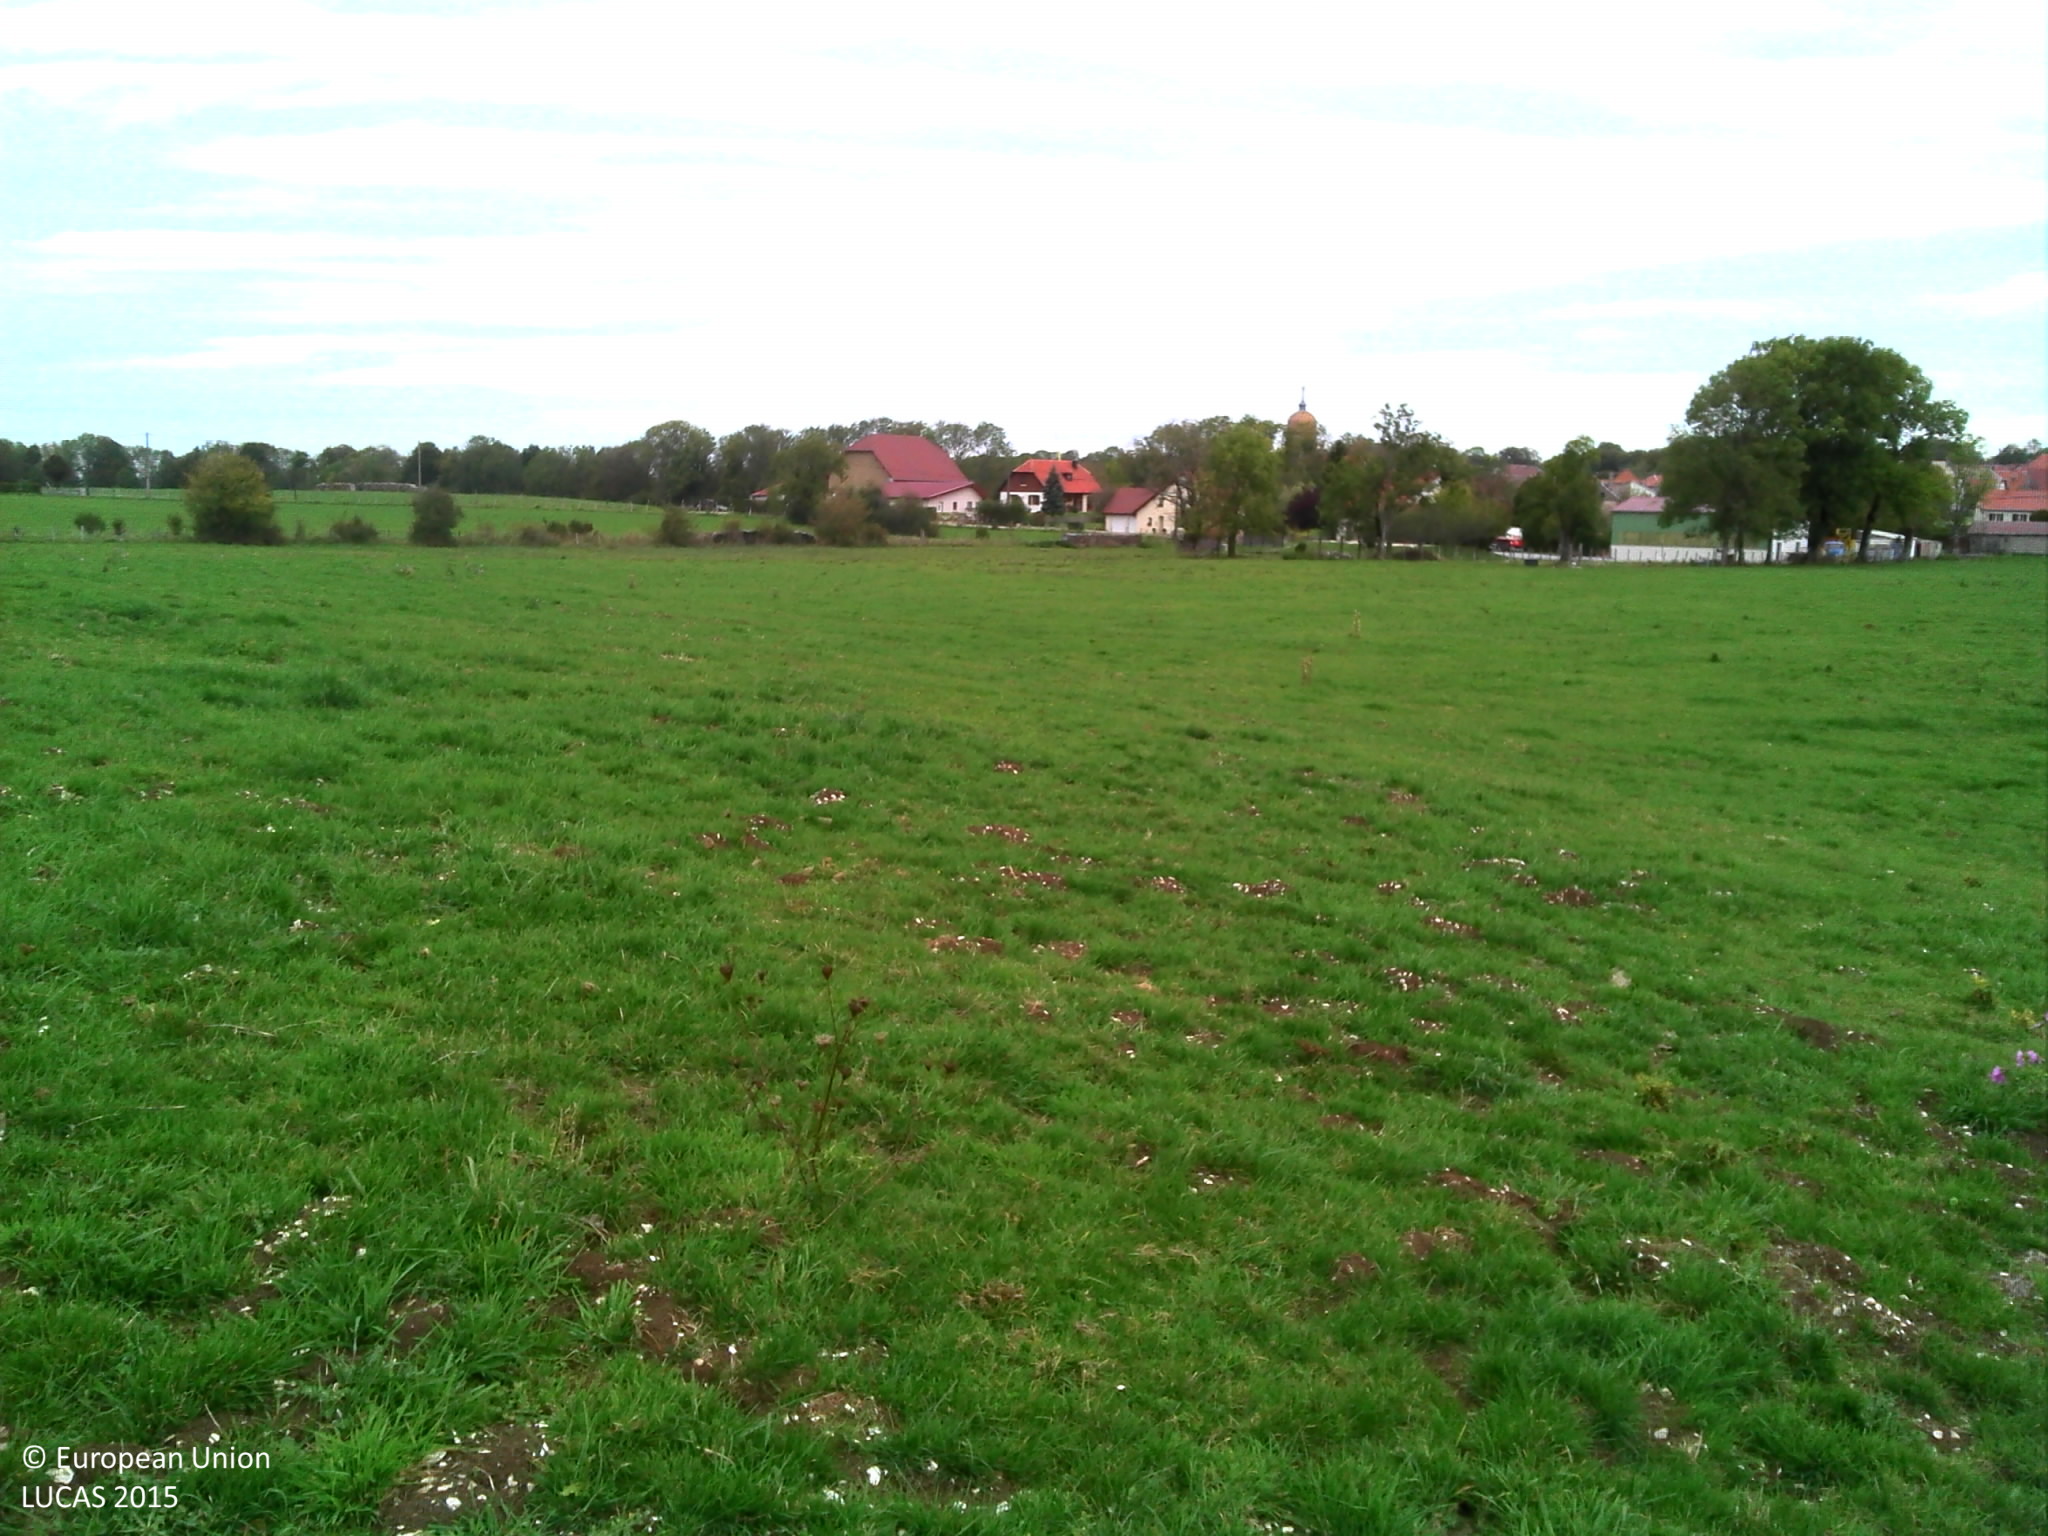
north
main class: Grassland
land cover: Grassland without tree/shrub cover
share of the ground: > 75 %
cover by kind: herbaceous plants 100 %
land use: Agriculture (excluding fallow land and kitchen gardens)
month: October
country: FR
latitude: 47.0390
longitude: 6.1460
